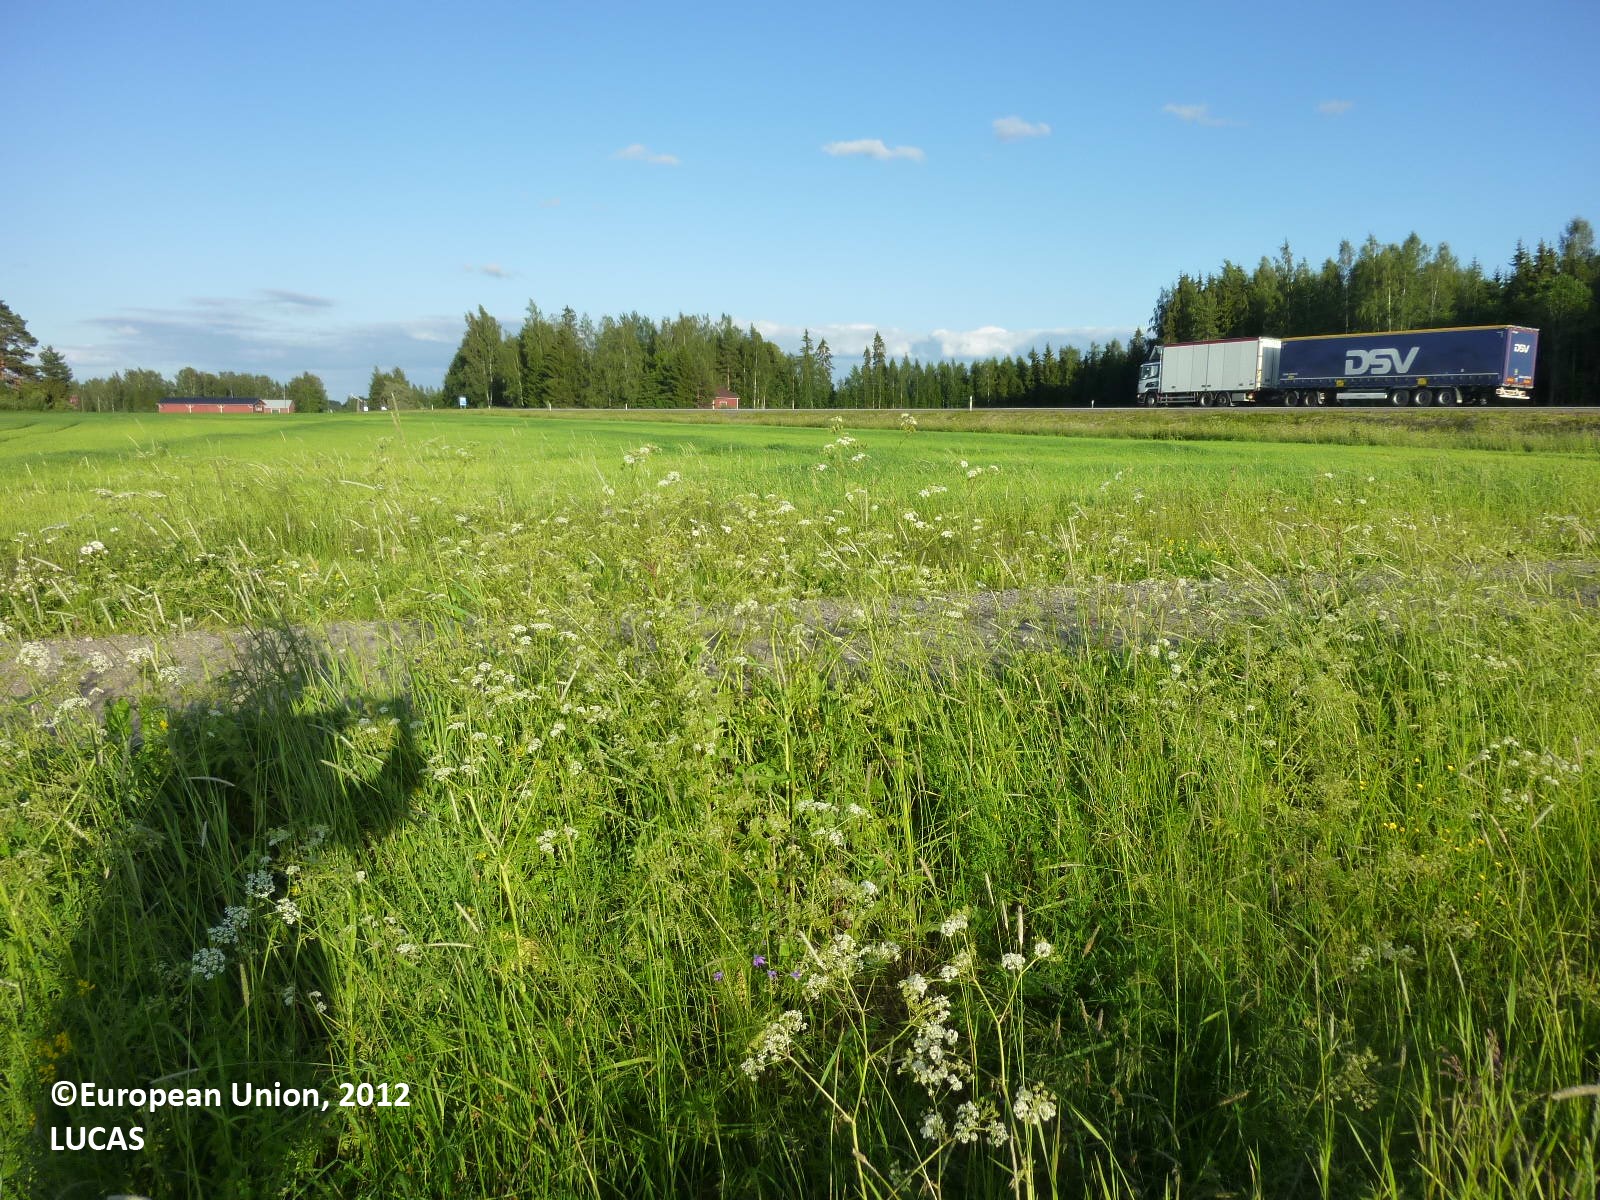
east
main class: Cropland
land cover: Barley
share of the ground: > 75 %
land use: Agriculture (excluding fallow land and kitchen gardens)
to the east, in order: Barley; Grass margins; Ditches and canals; Grass margins; Paved roads, cycling and walking lanes; Grass margins; Ditches and canals; Grass margins; Barley; Spruce dominated mixed woodland
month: July
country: FI
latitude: 61.1920
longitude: 22.5113
